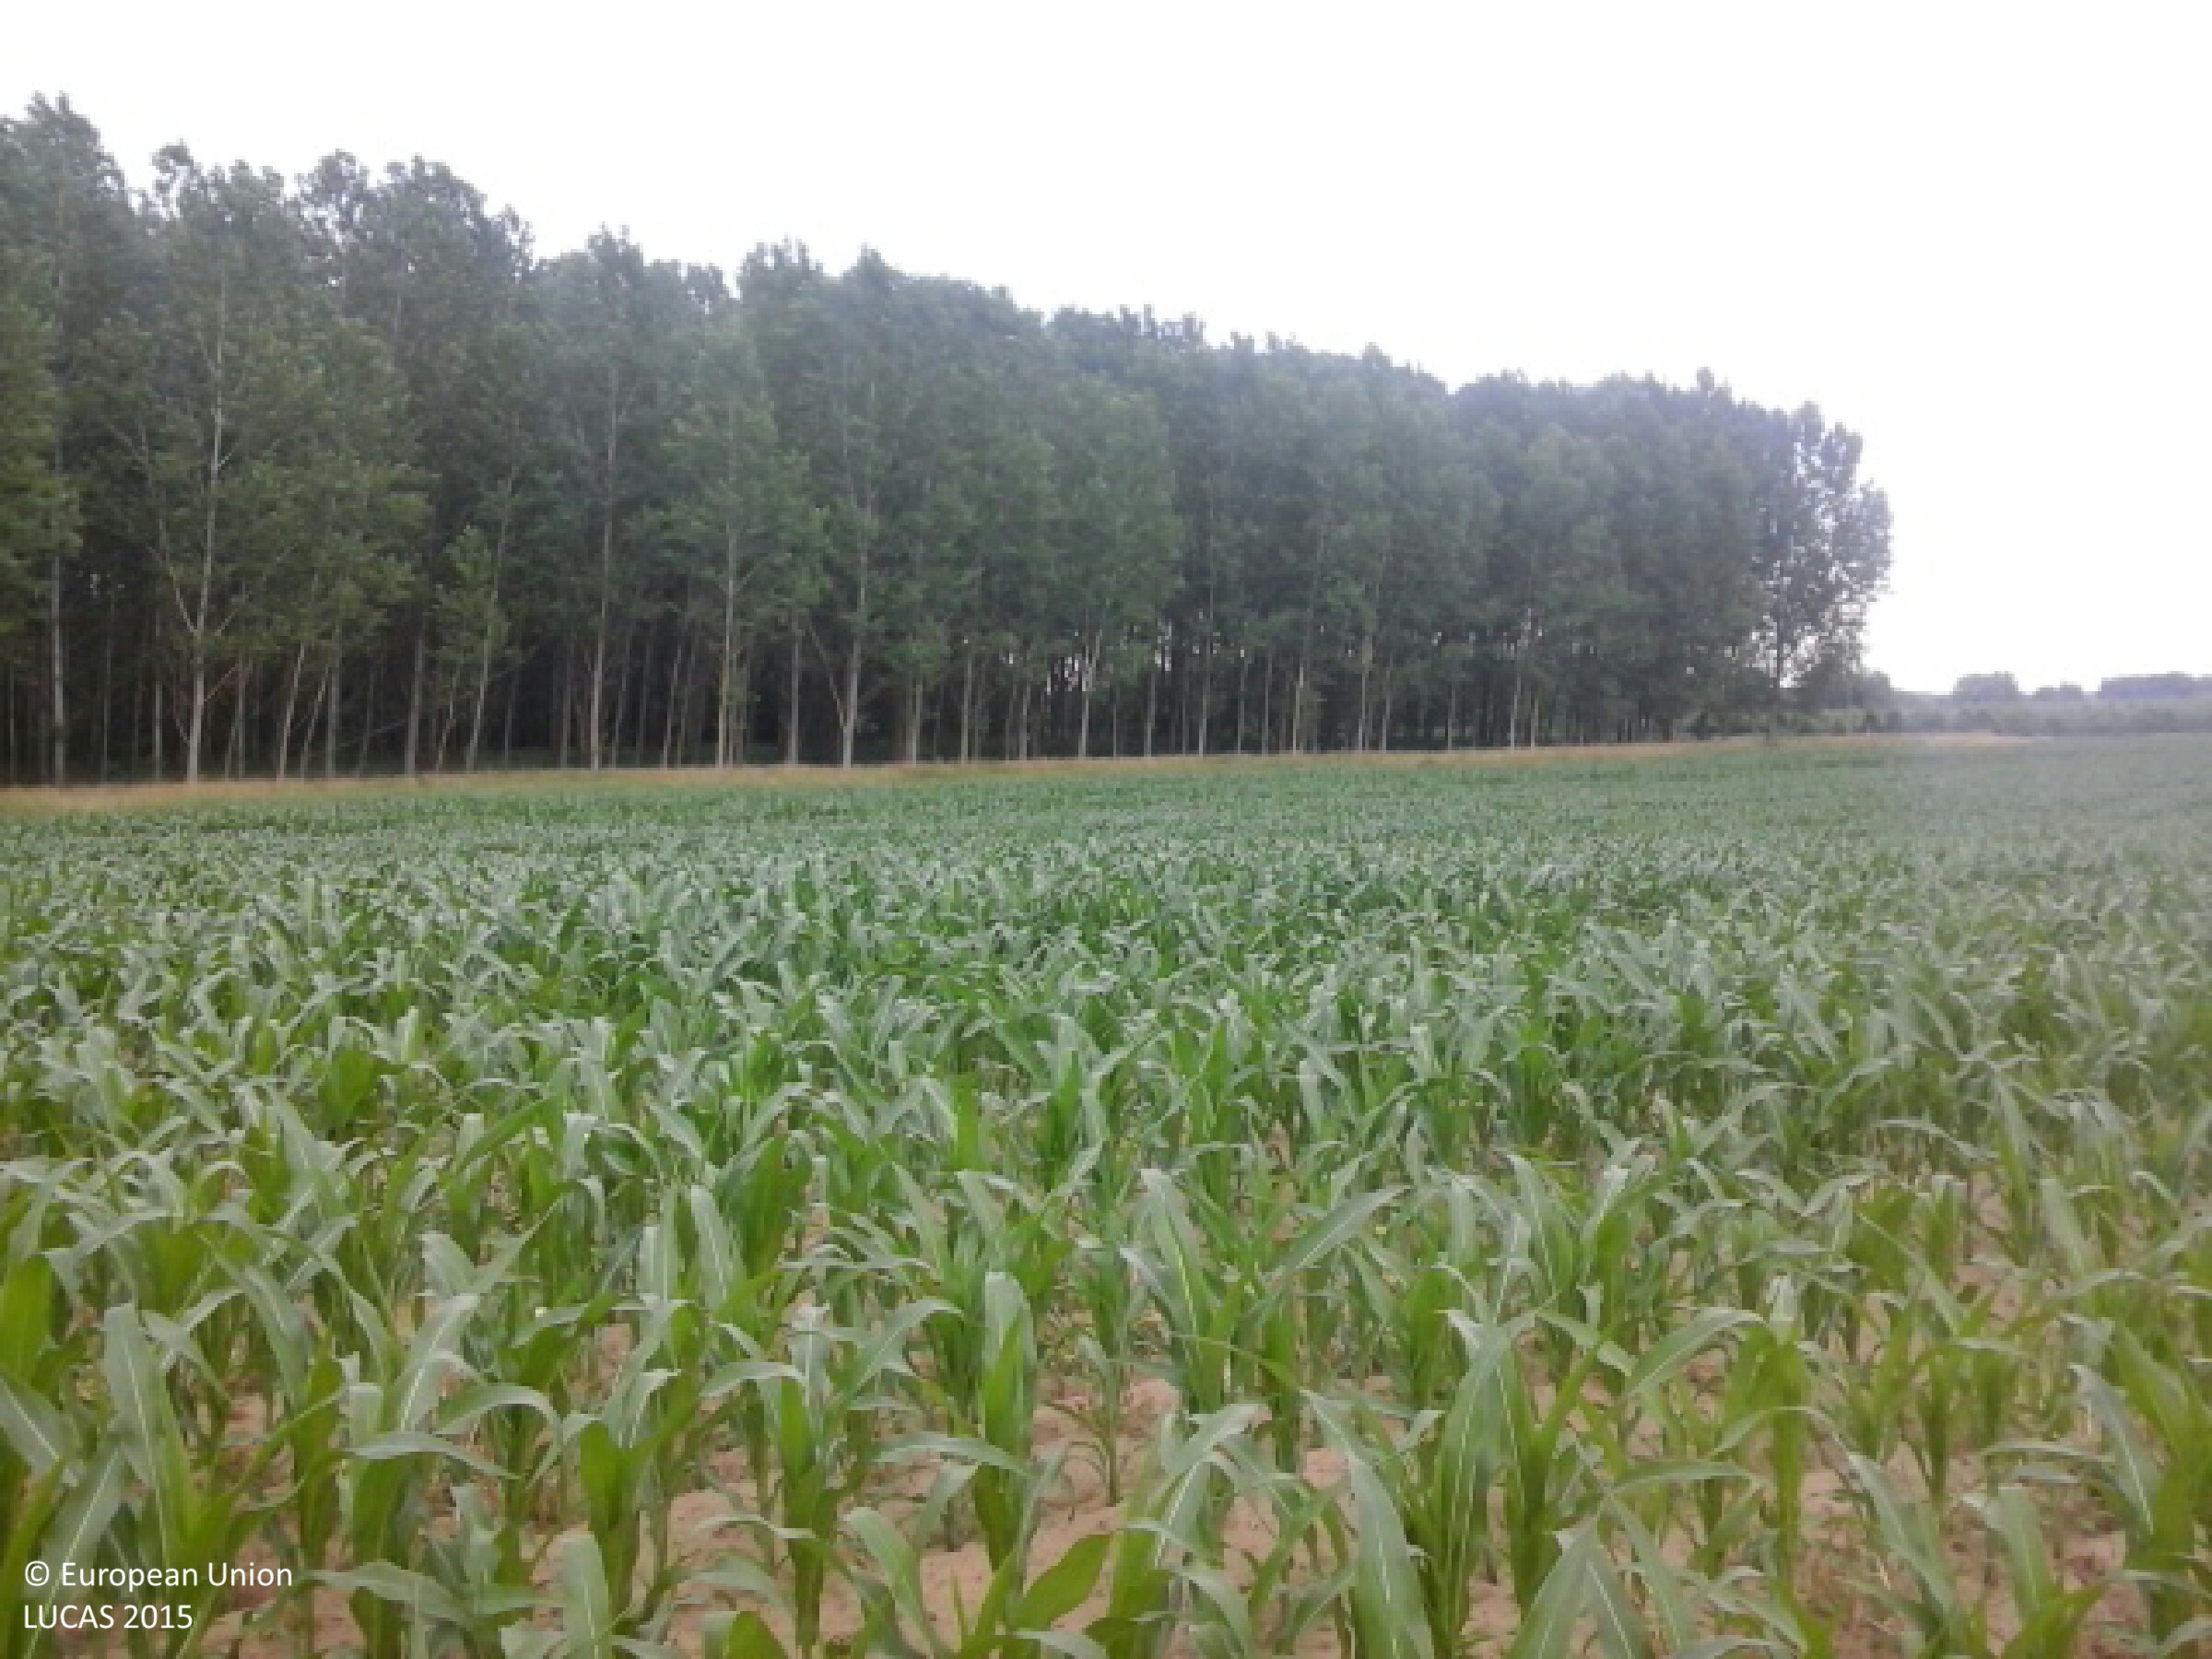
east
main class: Cropland
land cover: Maize
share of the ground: 25 - 50 %
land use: Agriculture (excluding fallow land and kitchen gardens)
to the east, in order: Maize; Ditches and canals; Grass margins; Broadleaved woodland; Grassland without tree/shrub cover; Broadleaved woodland
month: June
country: HU
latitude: 47.9879
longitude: 22.1267
